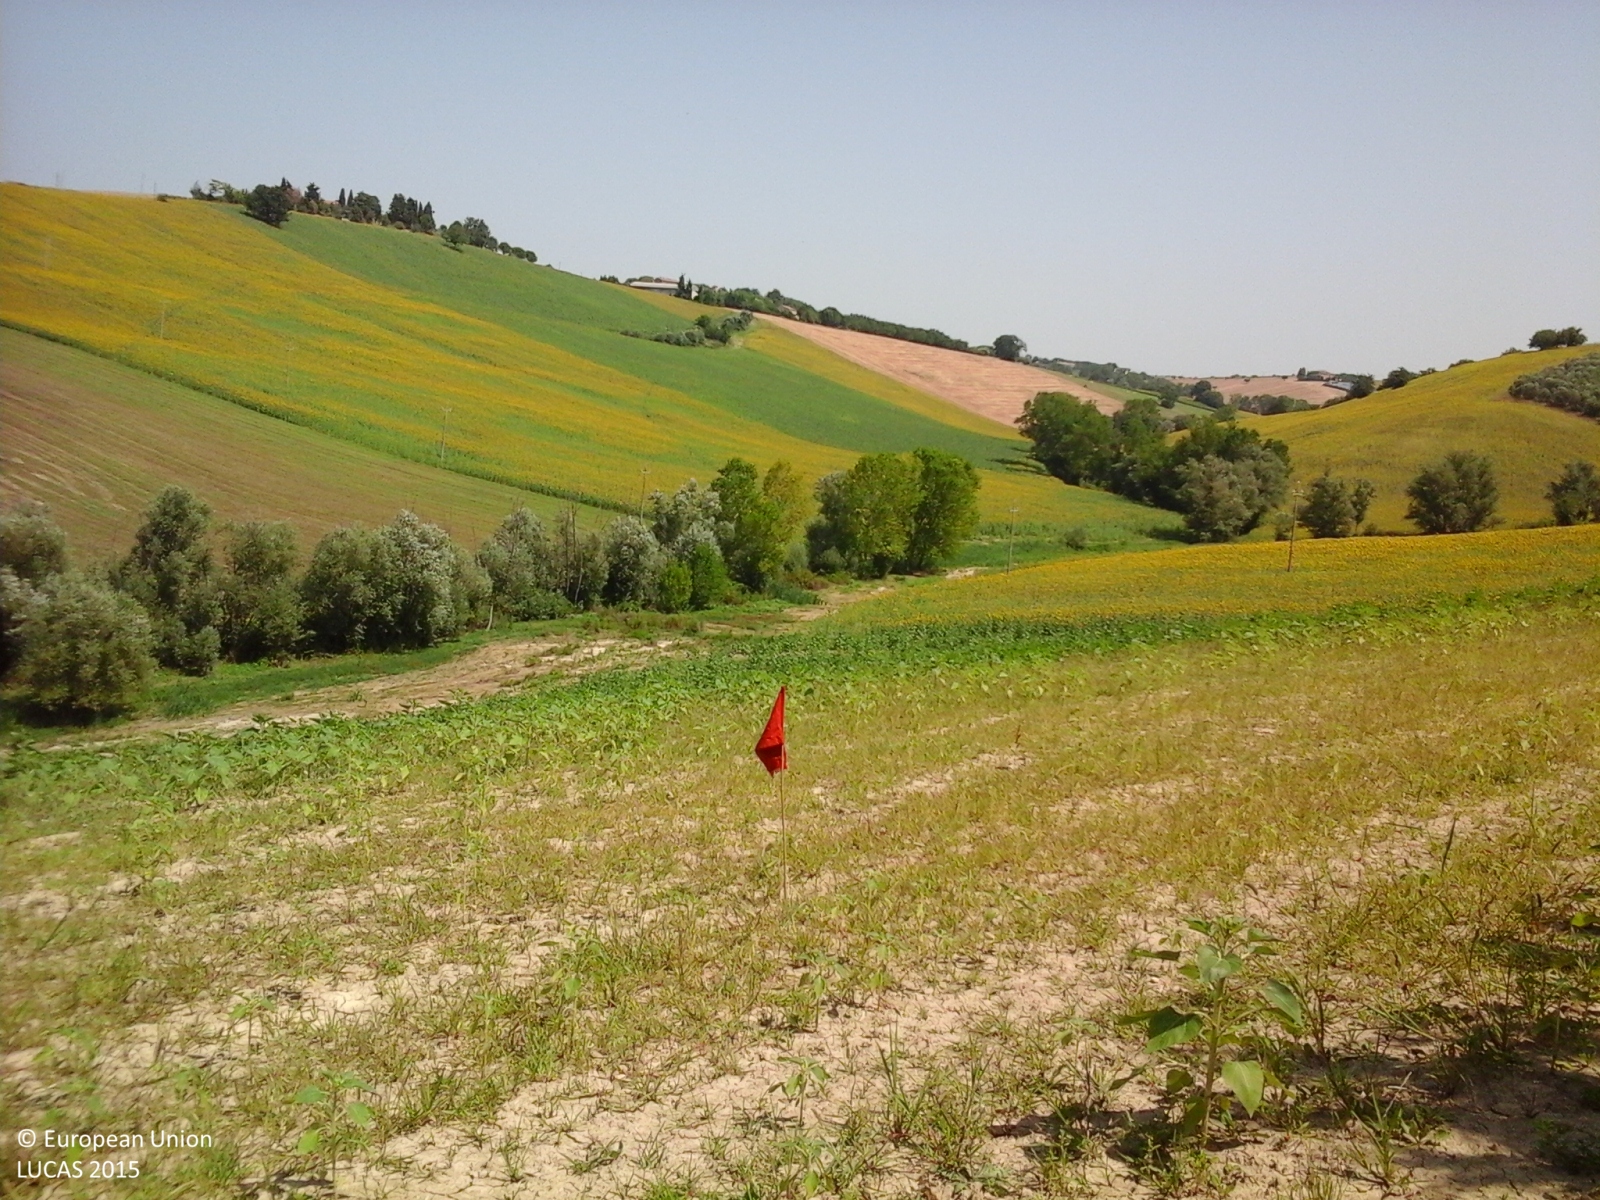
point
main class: Cropland
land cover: Sunflower
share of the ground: 25 - 50 %
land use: Agriculture (excluding fallow land and kitchen gardens)
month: July
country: IT
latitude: 43.3900
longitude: 13.4603
